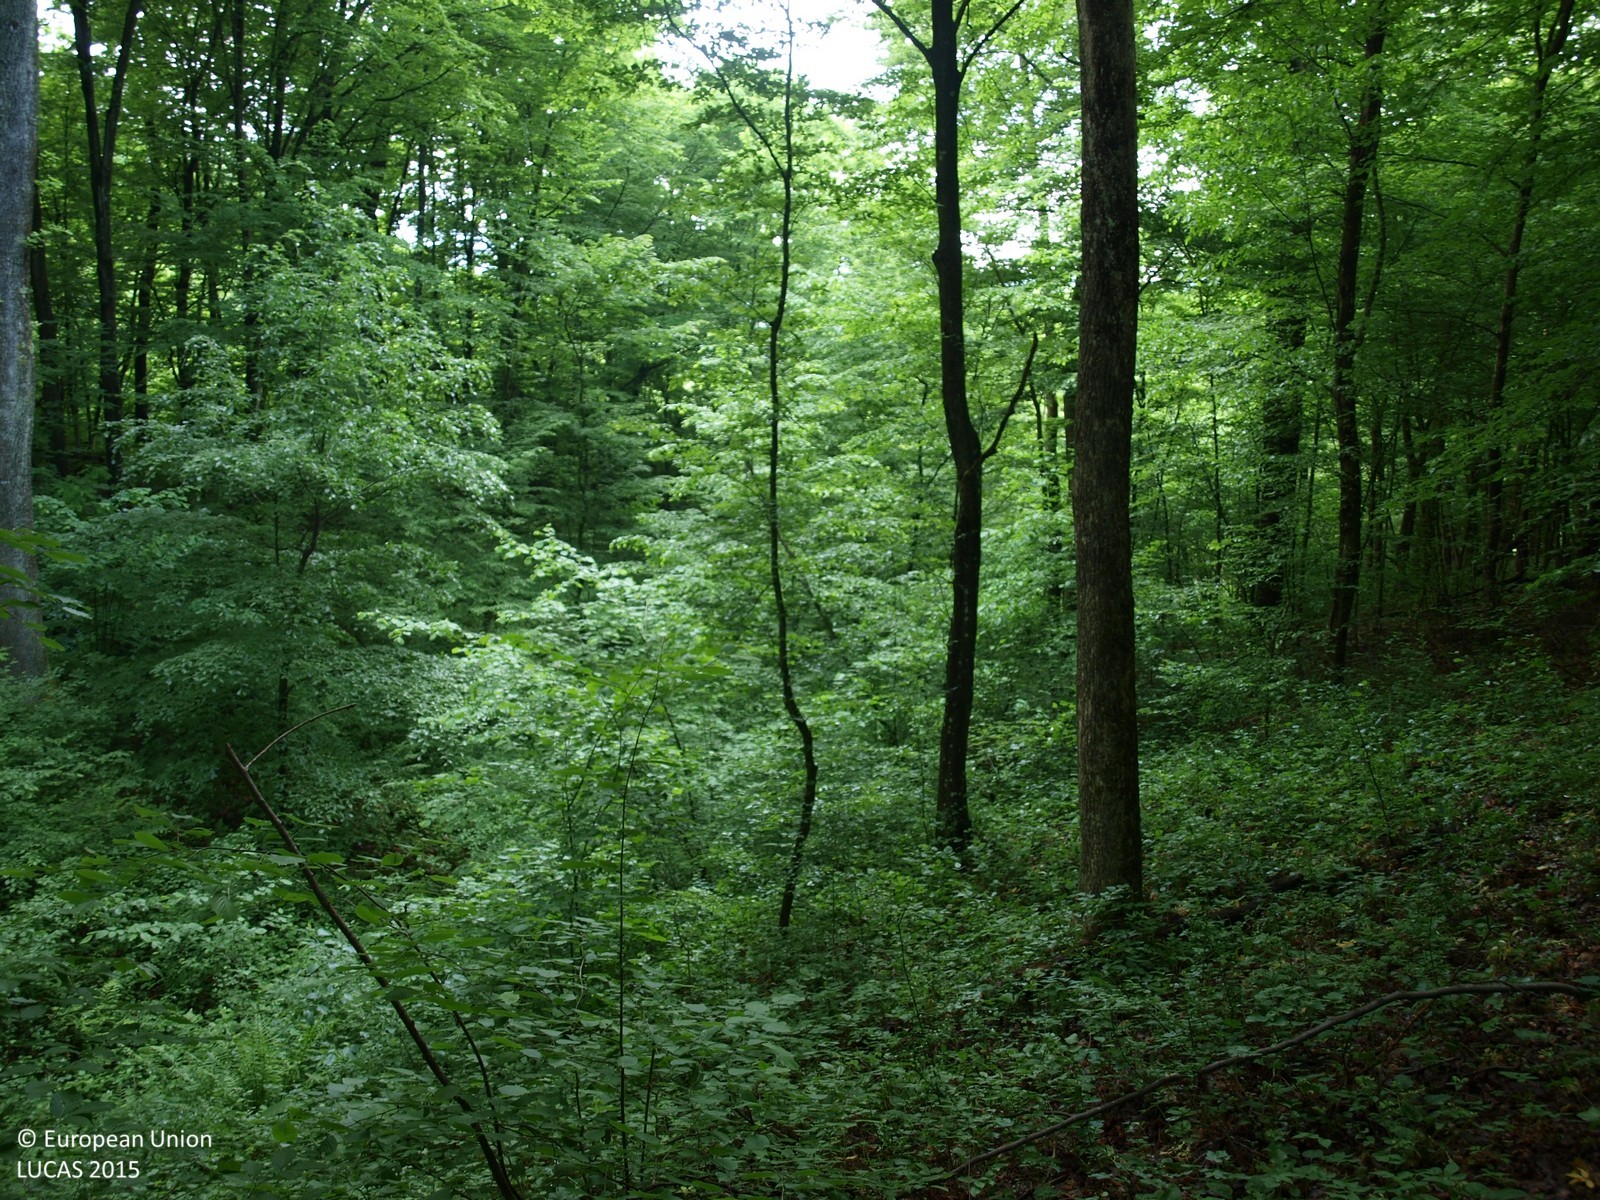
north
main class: Woodland
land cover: Broadleaved woodland
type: mesophytic deciduous forest
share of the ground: > 75 %
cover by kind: broadleaved forest trees 95 %, shrubs 5 %
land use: Forestry
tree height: > 5 m
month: May
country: HR
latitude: 46.1352
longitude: 16.1995
